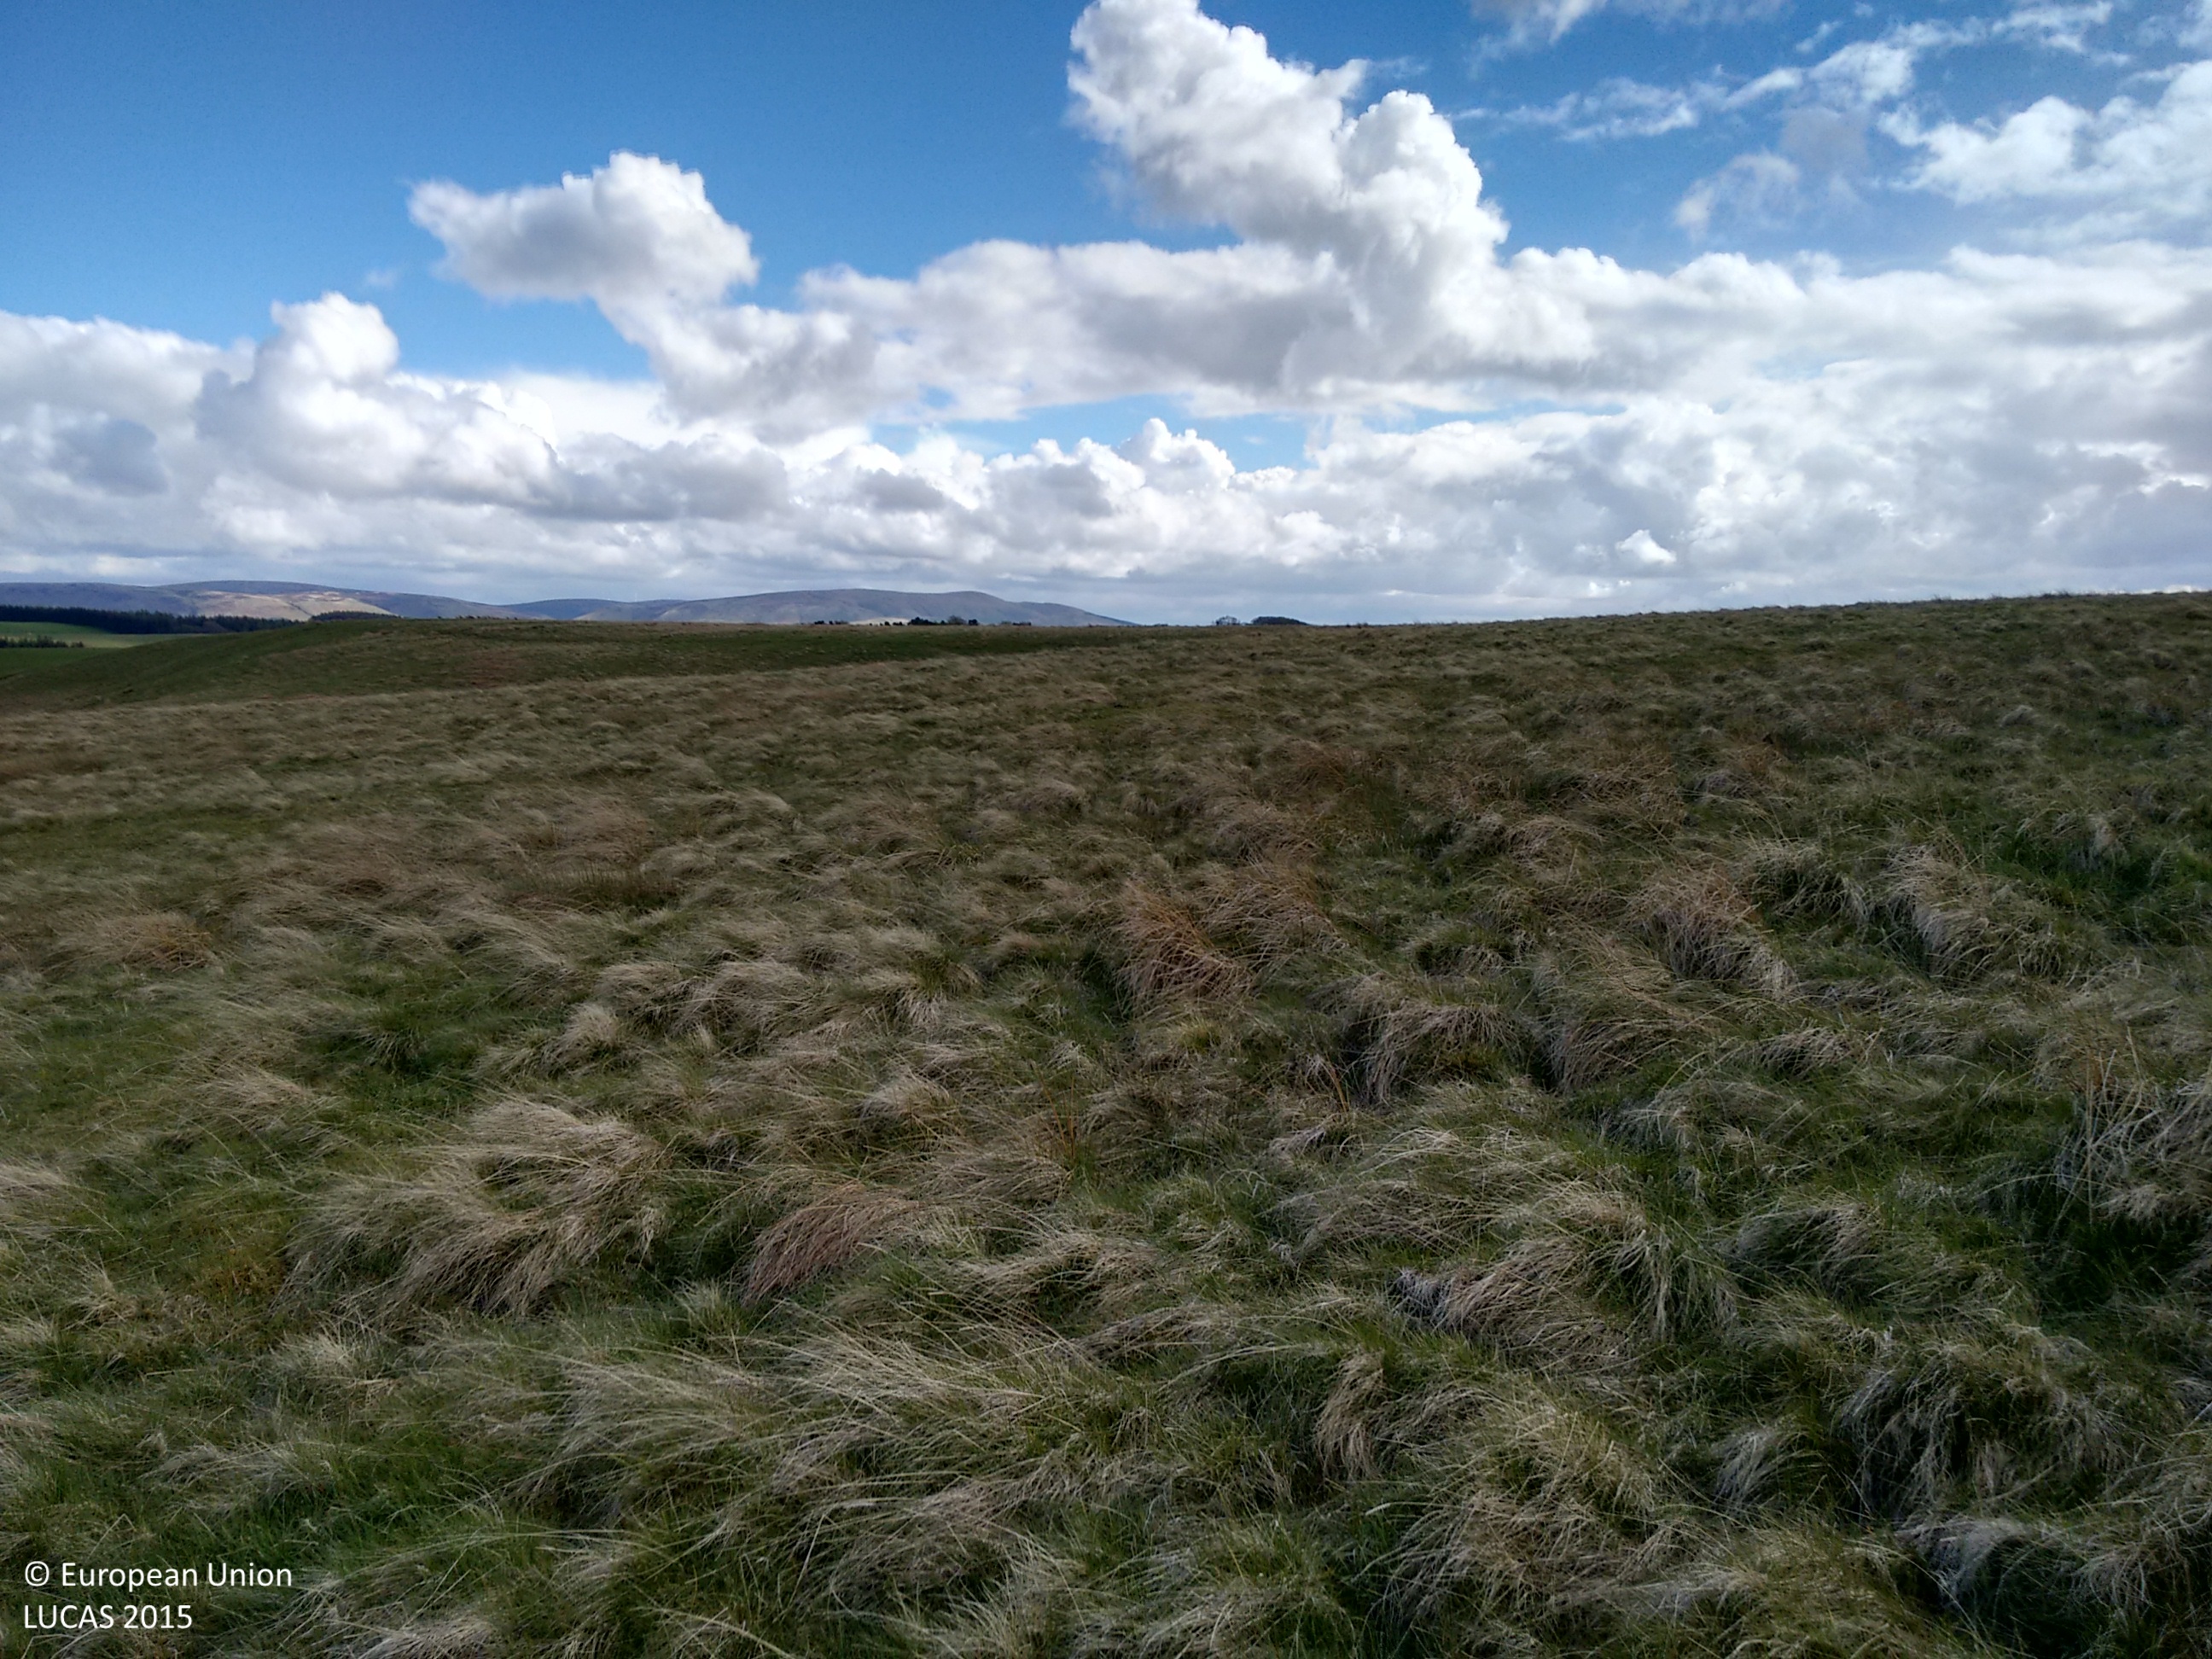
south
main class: Grassland
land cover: Grassland without tree/shrub cover
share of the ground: > 75 %
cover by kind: herbaceous plants 100 %
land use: Agriculture (excluding fallow land and kitchen gardens)
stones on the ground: < 10 %
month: May
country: GB
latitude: 55.8181
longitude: -3.1422
